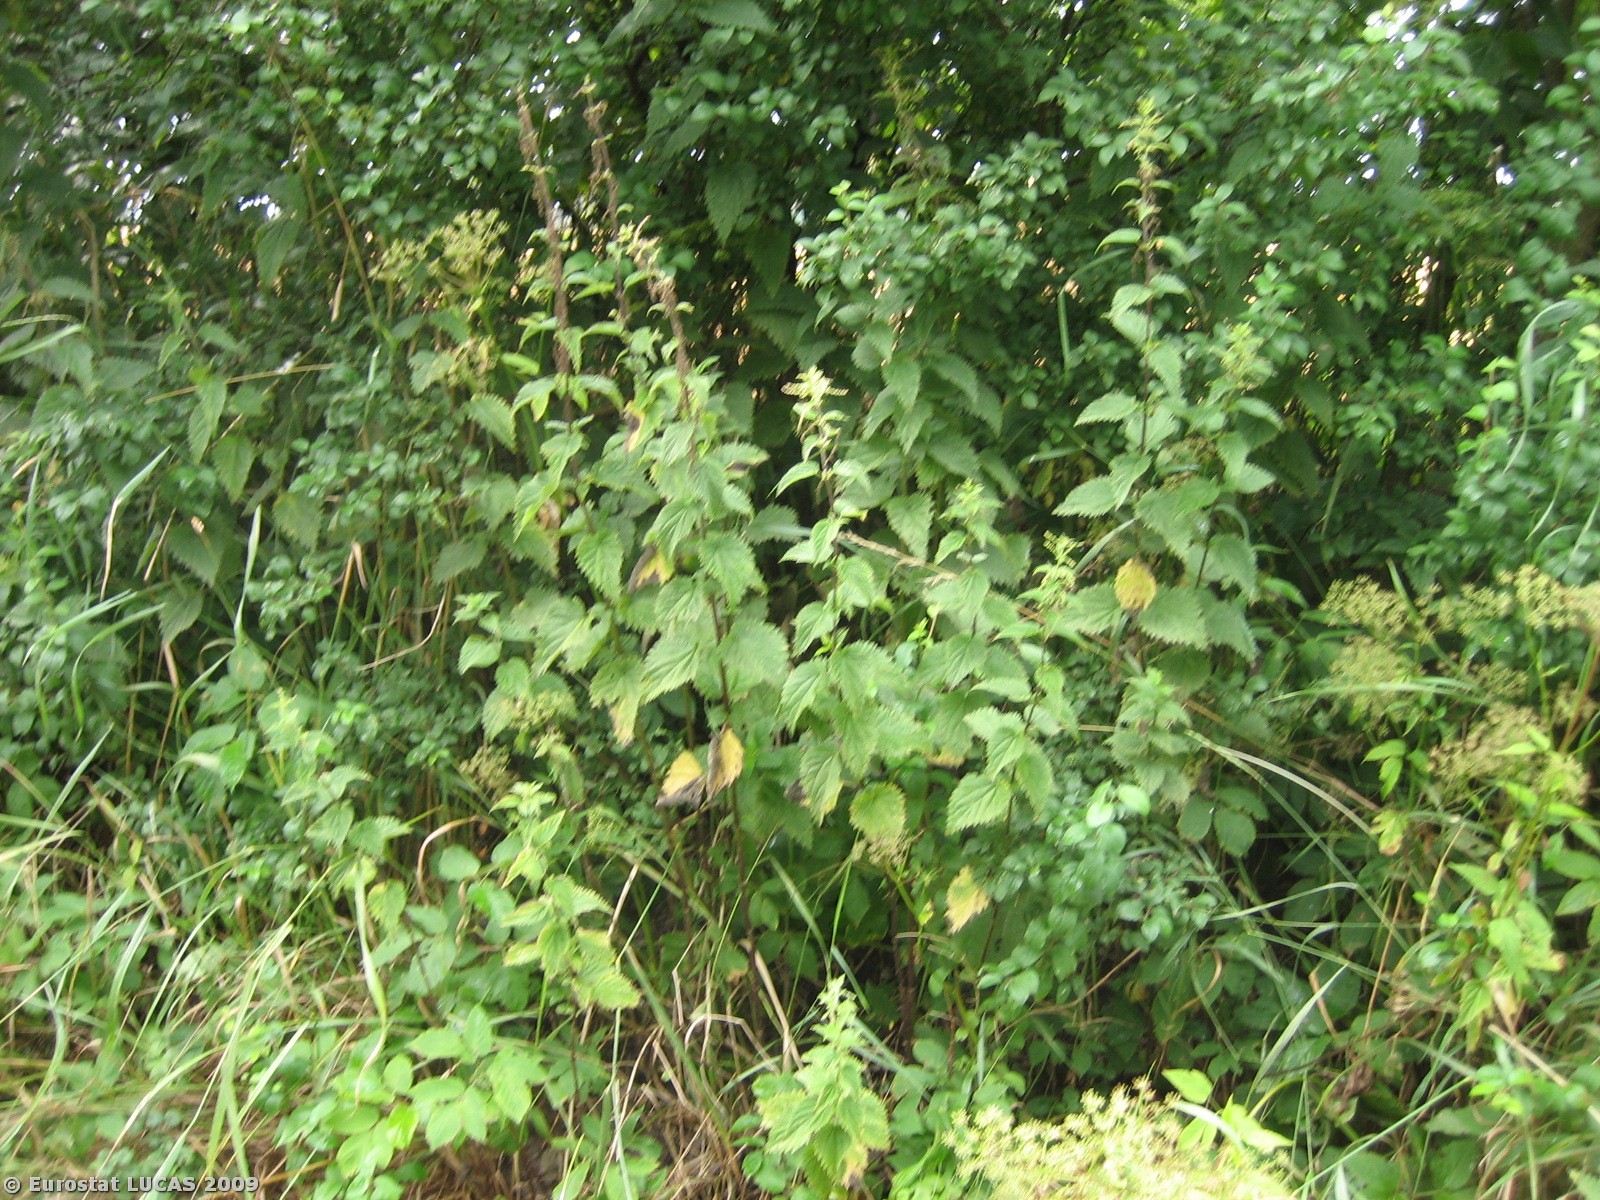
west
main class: Woodland
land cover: Broadleaved woodland
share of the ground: > 75 %
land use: Residential
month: July
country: DK
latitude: 55.3249
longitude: 9.9213
